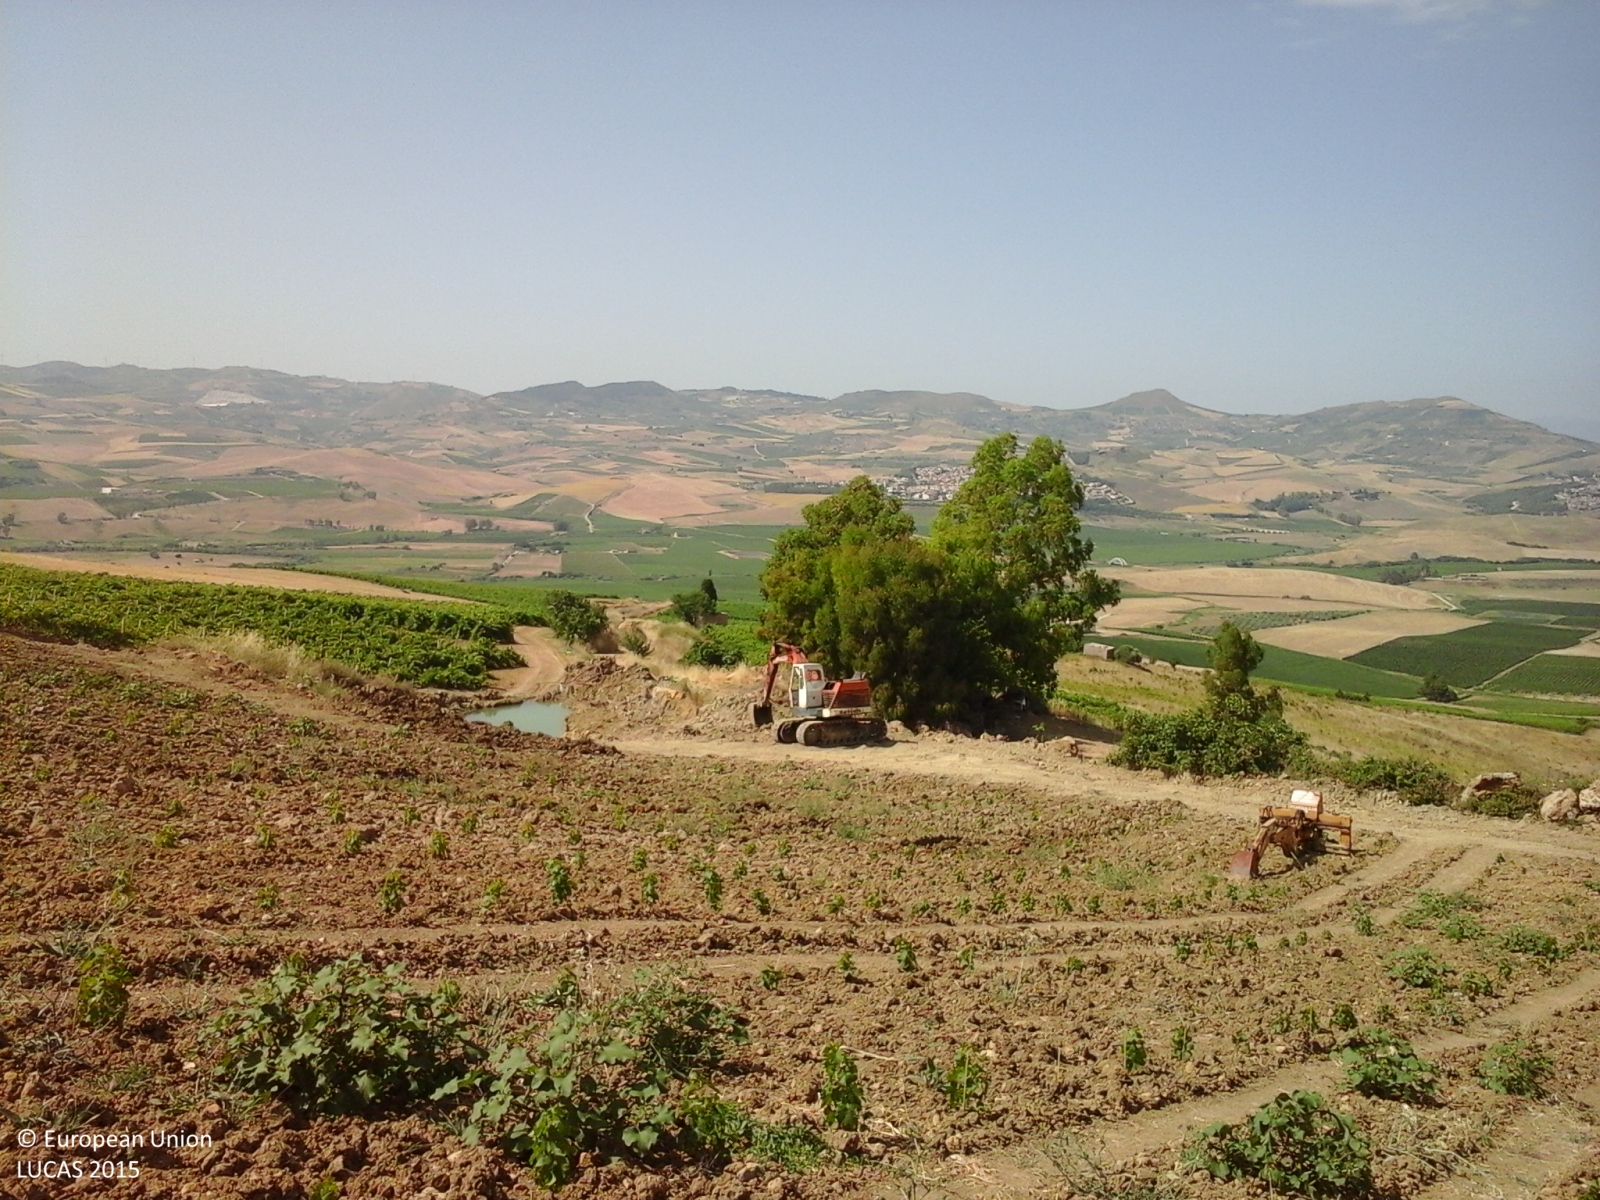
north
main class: Cropland
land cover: Vineyards
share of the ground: < 10 %
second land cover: Other bare soil
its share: > 75 %
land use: Agriculture (excluding fallow land and kitchen gardens)
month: June
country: IT
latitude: 37.7182
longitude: 13.0065
